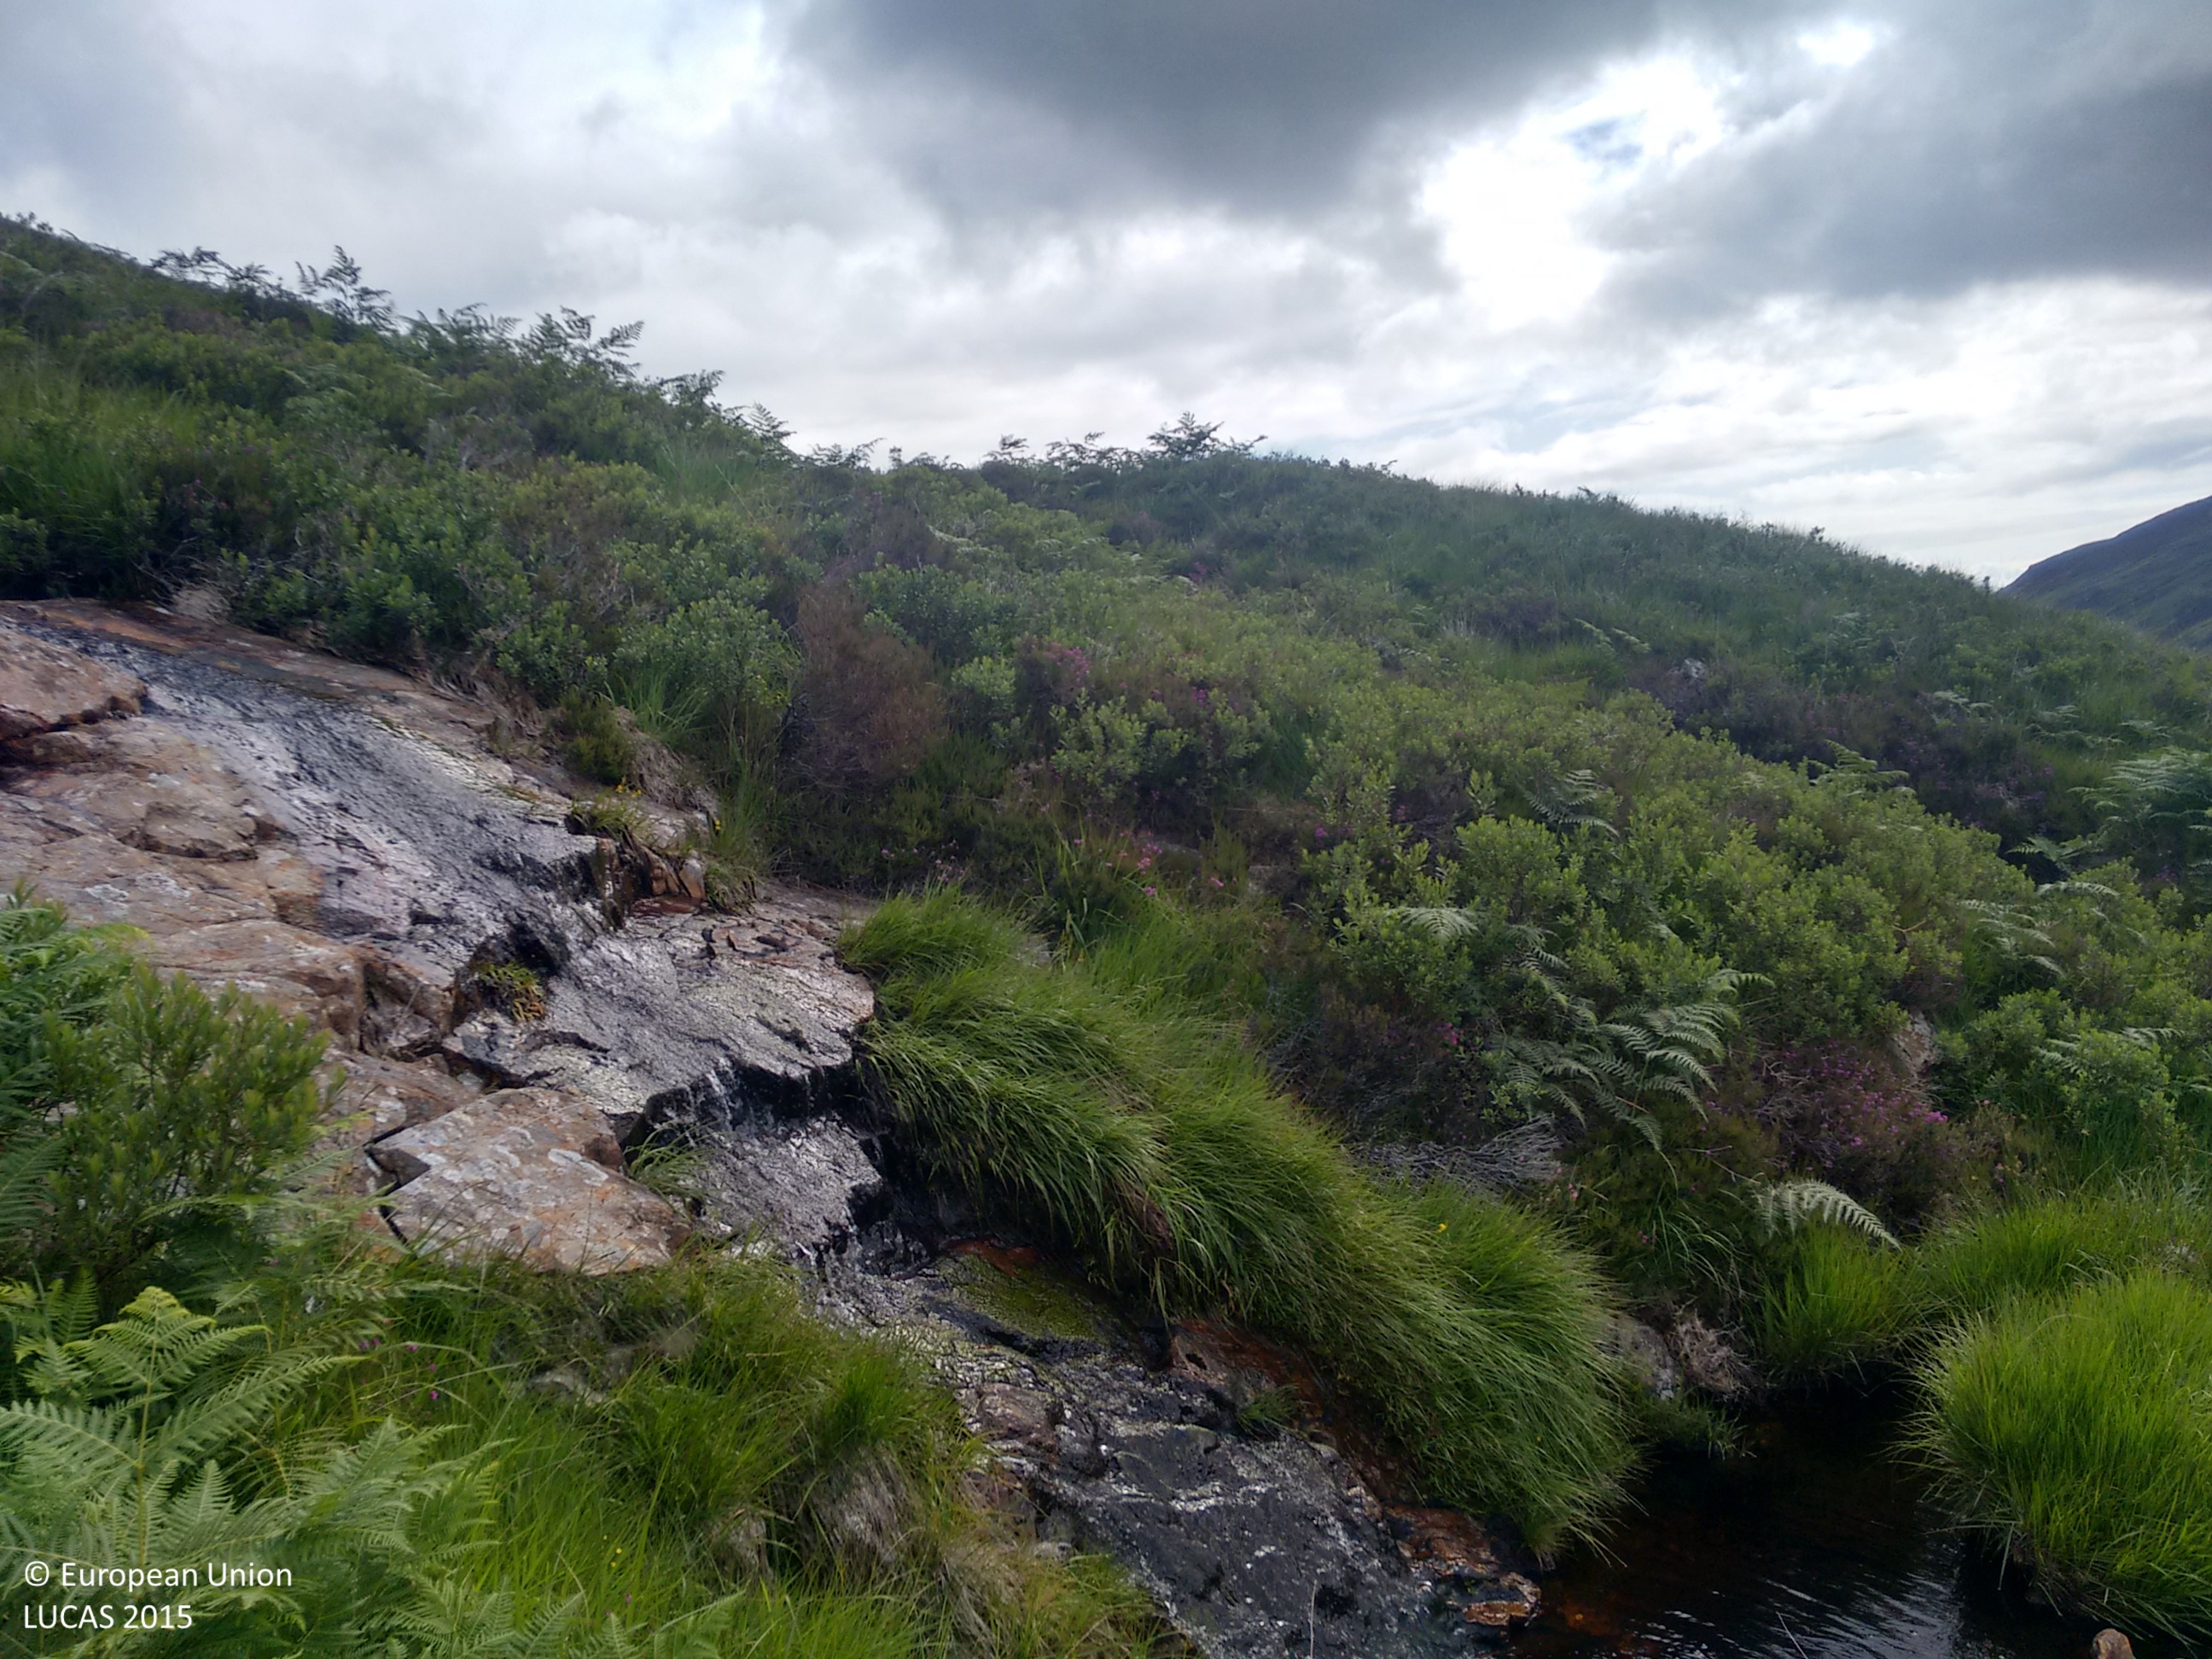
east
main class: Shrubland
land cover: Shrubland without tree cover
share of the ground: > 75 %
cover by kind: shrubs 80 %, herbaceous plants 20 %
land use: Semi-natural and natural areas not in use
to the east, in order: Shrubland without tree cover; Rivers and streams; Shrubland without tree cover; Rivers and streams; Shrubland without tree cover
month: July
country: GB
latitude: 55.6769
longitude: -5.2074
